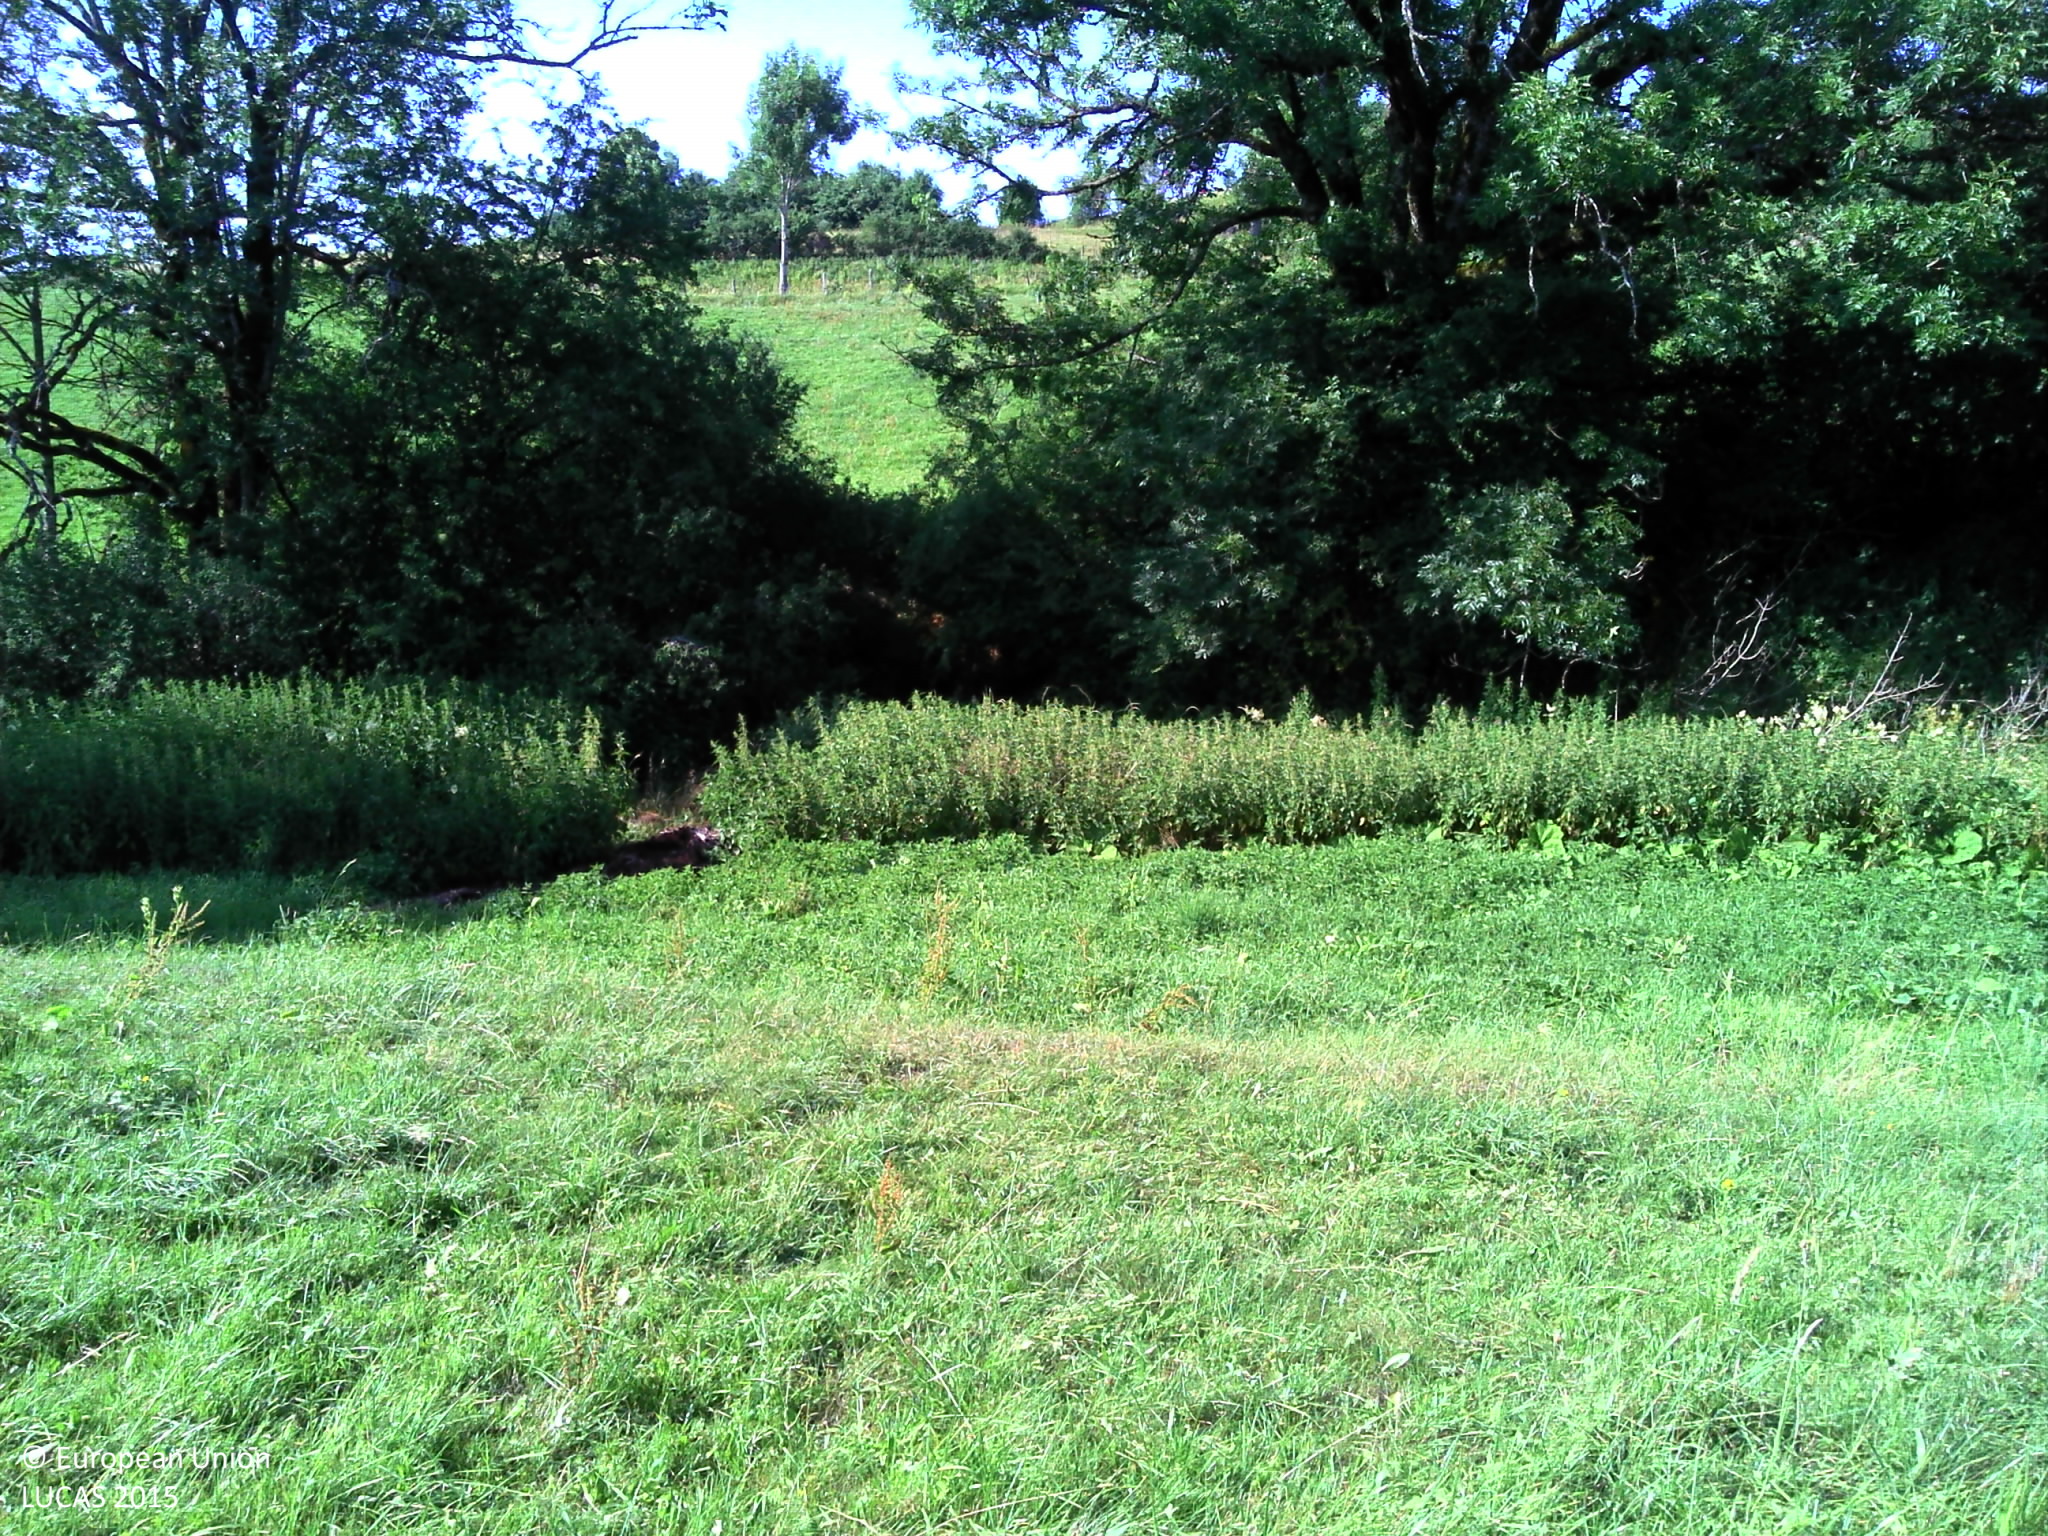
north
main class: Grassland
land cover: Grassland without tree/shrub cover
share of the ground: > 75 %
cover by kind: herbaceous plants 100 %
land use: Agriculture (excluding fallow land and kitchen gardens)
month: July
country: FR
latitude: 46.7845
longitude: 6.0860
